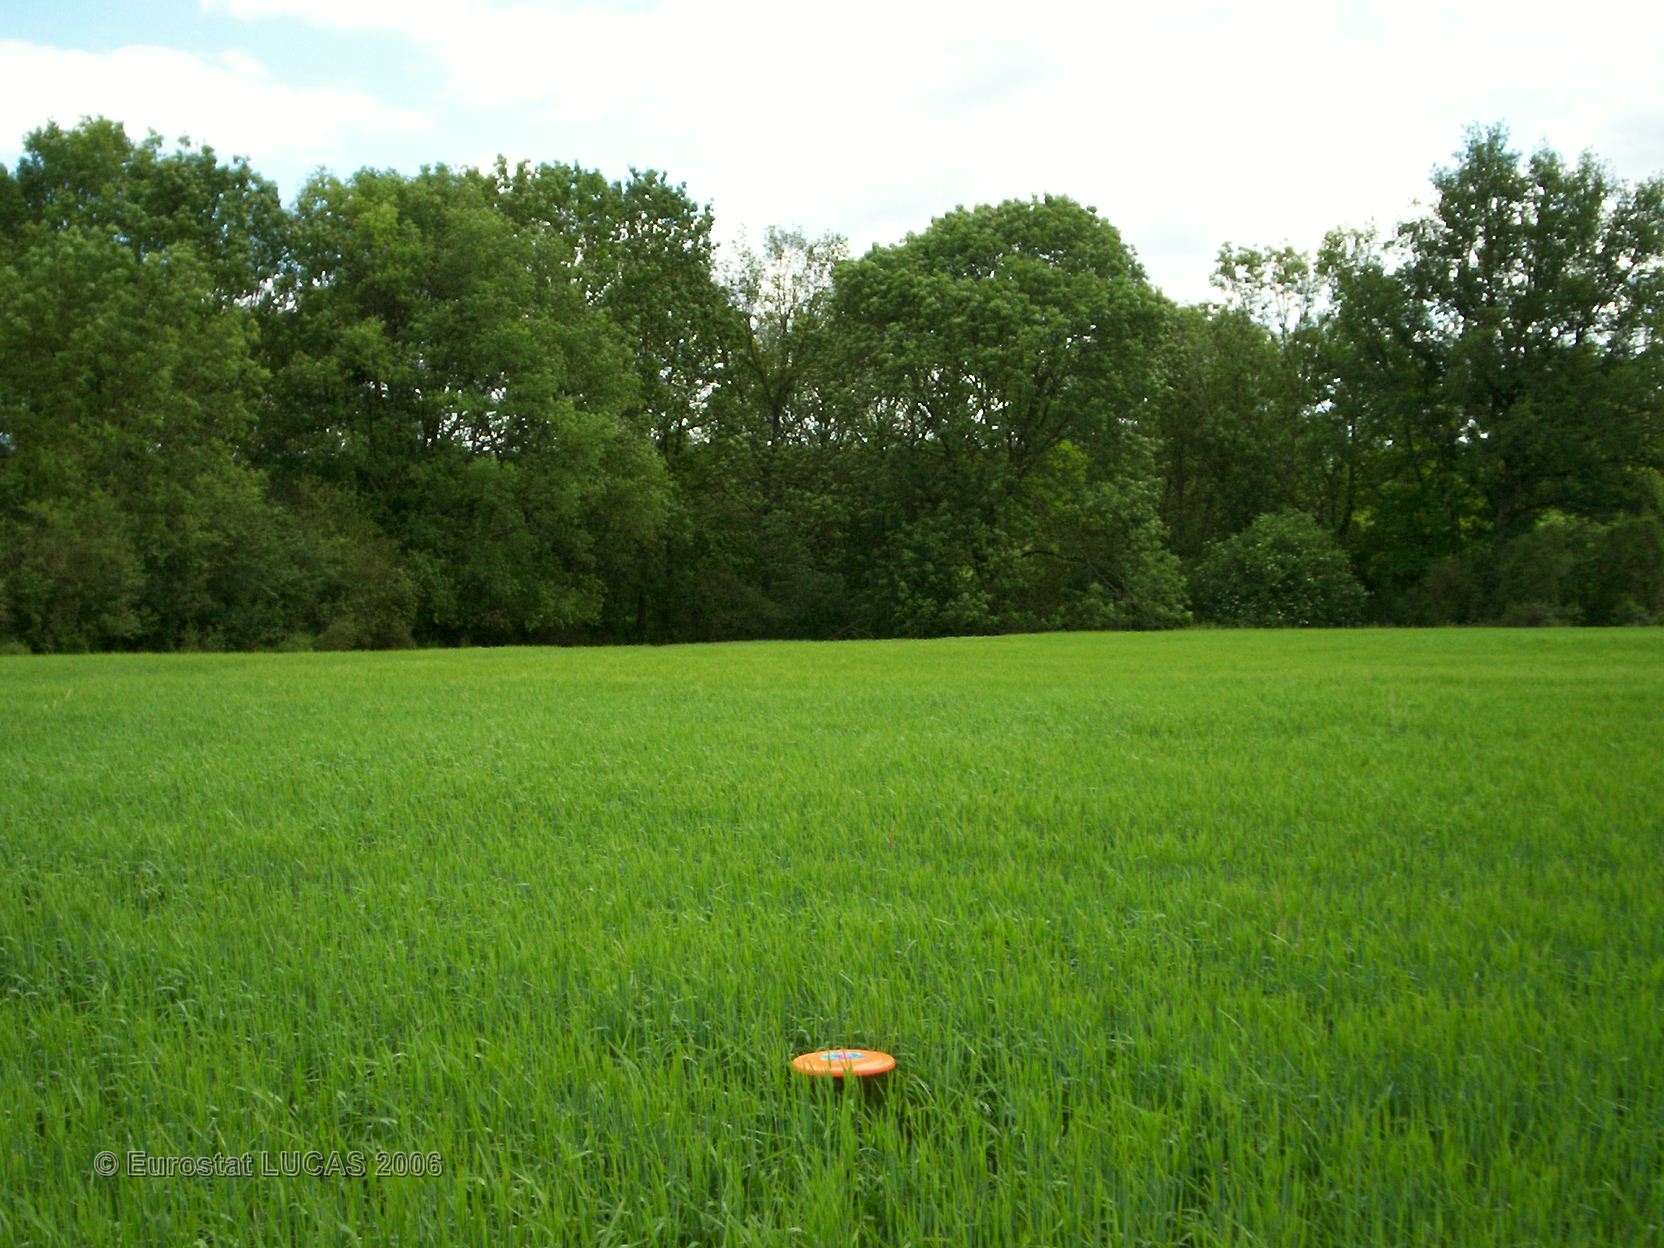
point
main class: Cropland
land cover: Barley
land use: Agriculture (excluding fallow land and kitchen gardens)
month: May
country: FR
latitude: 48.5675
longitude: 2.8220
